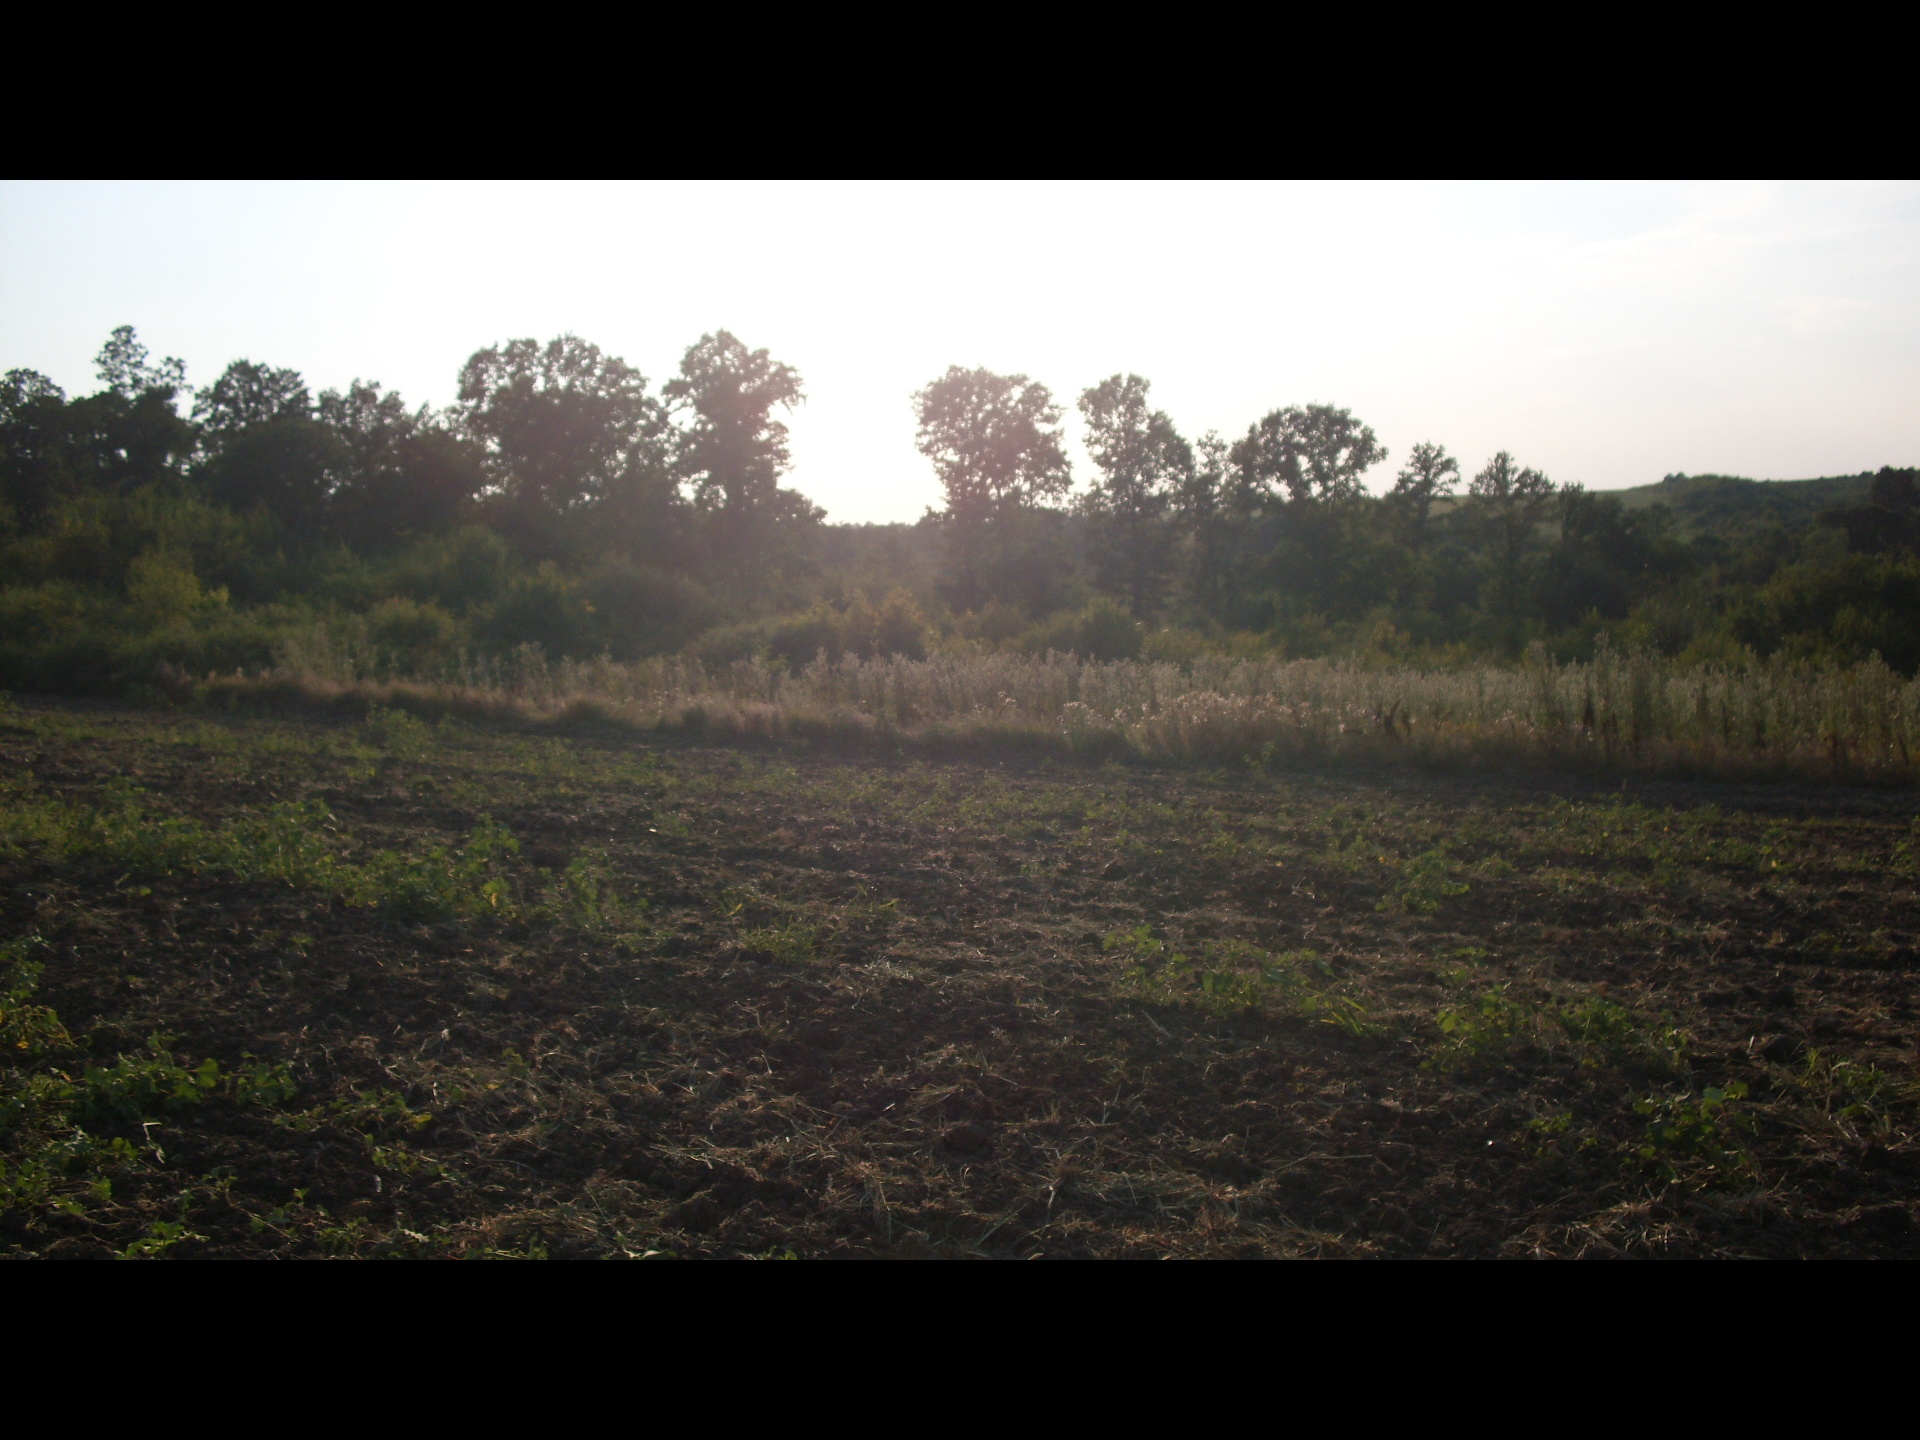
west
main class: Grassland
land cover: Spontaneously vegetated surfaces
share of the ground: 10 - 25 %
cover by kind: herbaceous plants 100 %
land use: Fallow land
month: August
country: BG
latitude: 43.3391
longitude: 23.4753
